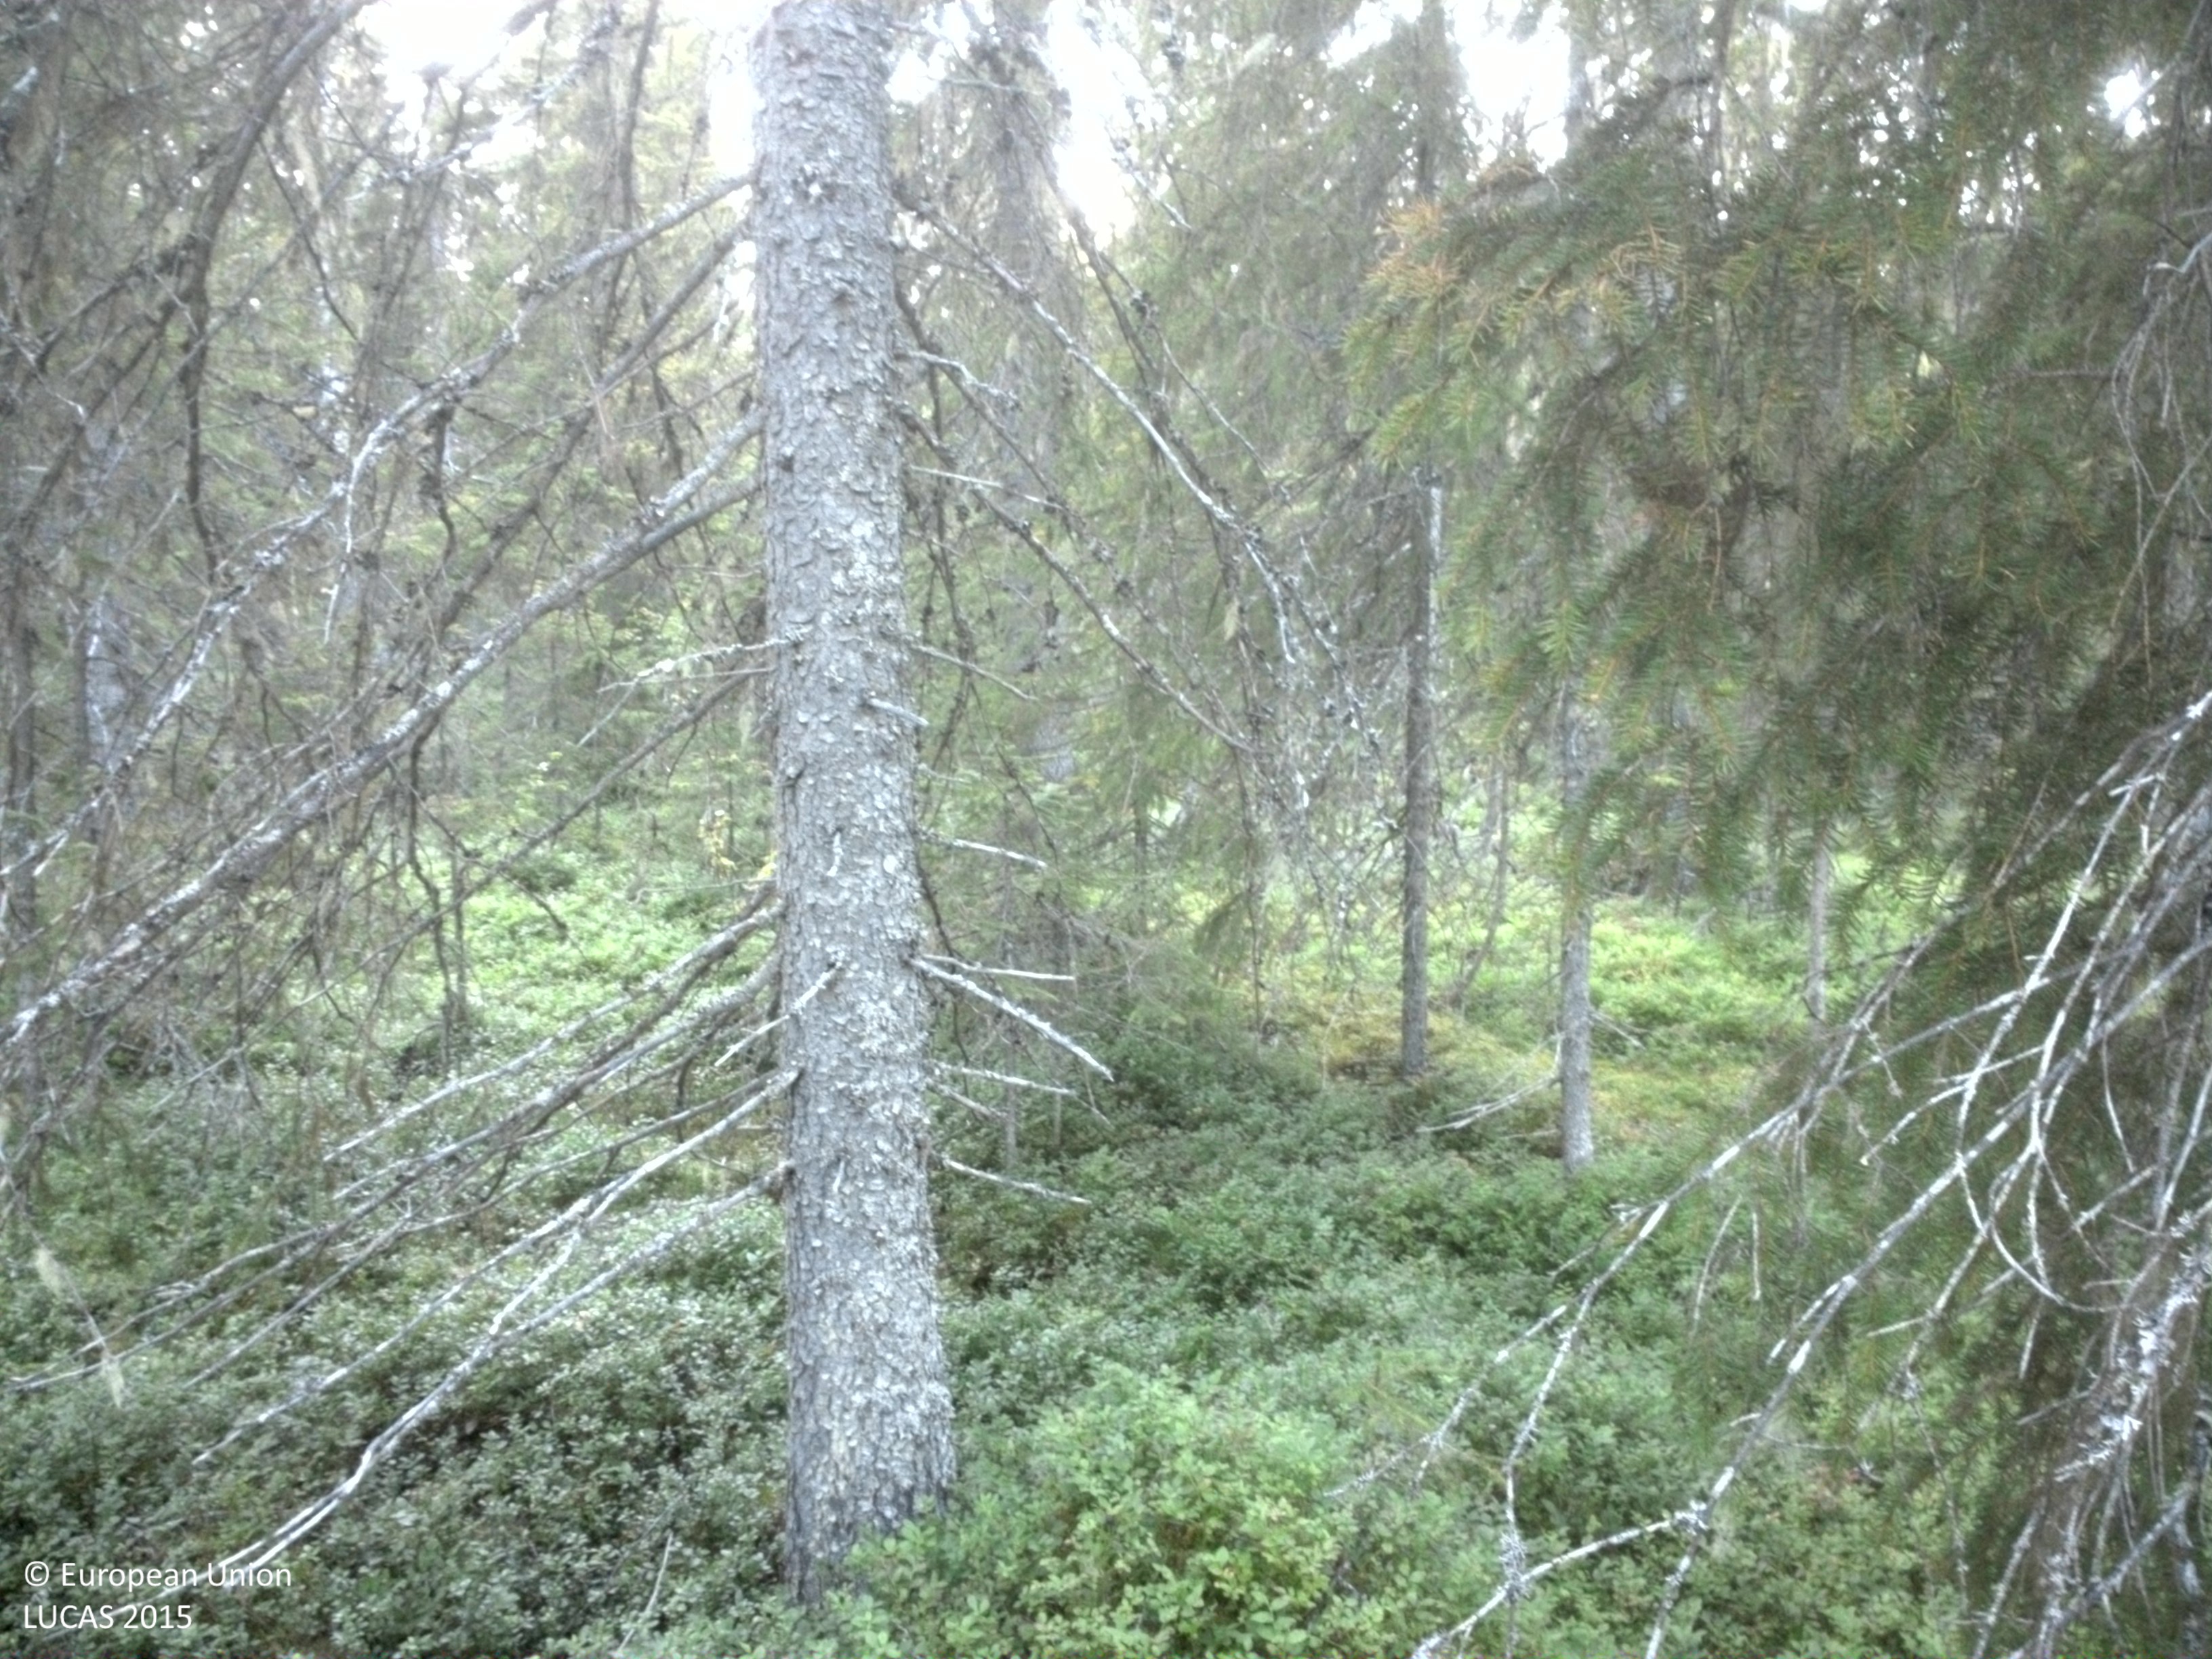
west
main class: Woodland
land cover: Spruce dominated coniferous woodland
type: boreal forest
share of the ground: 50 - 75 %
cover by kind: coniferous forest trees 60 %, shrubs 40 %
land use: Forestry
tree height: > 5 m
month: September
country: SE
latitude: 64.7134
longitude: 19.8118
